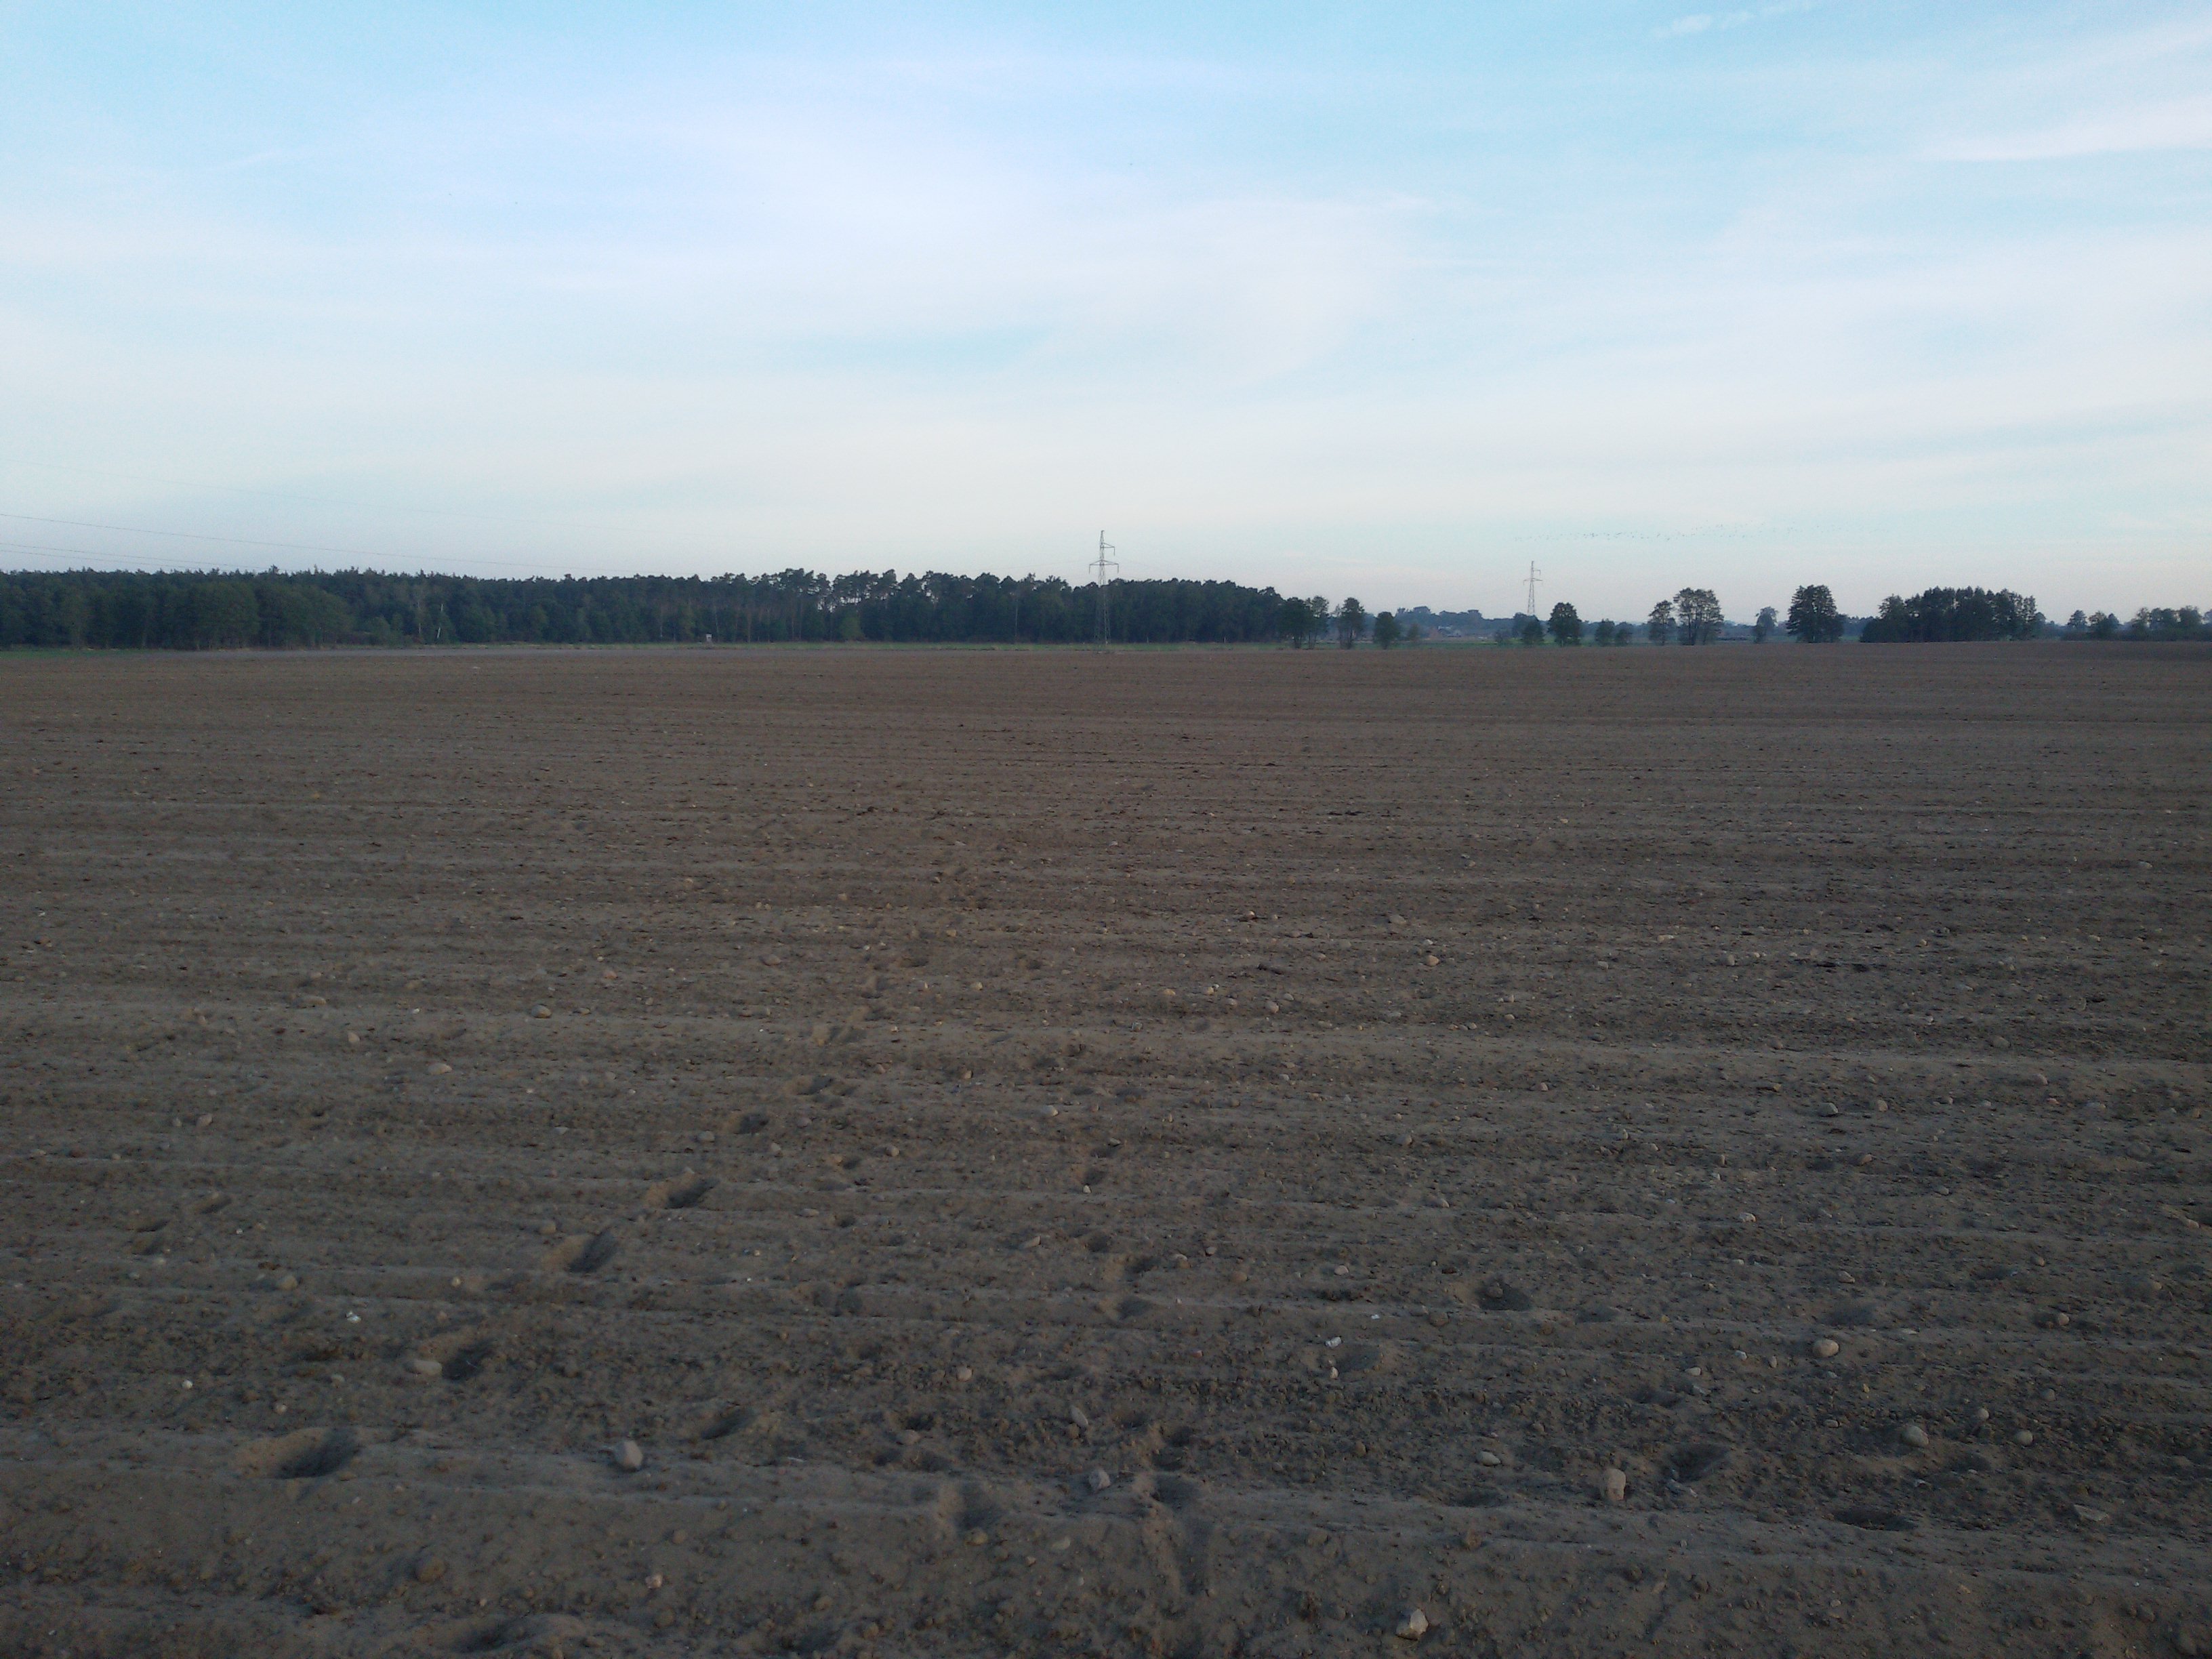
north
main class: Cropland
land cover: Rye
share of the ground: < 10 %
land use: Agriculture (excluding fallow land and kitchen gardens)
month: October
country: PL
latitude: 51.6608
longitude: 17.3704
